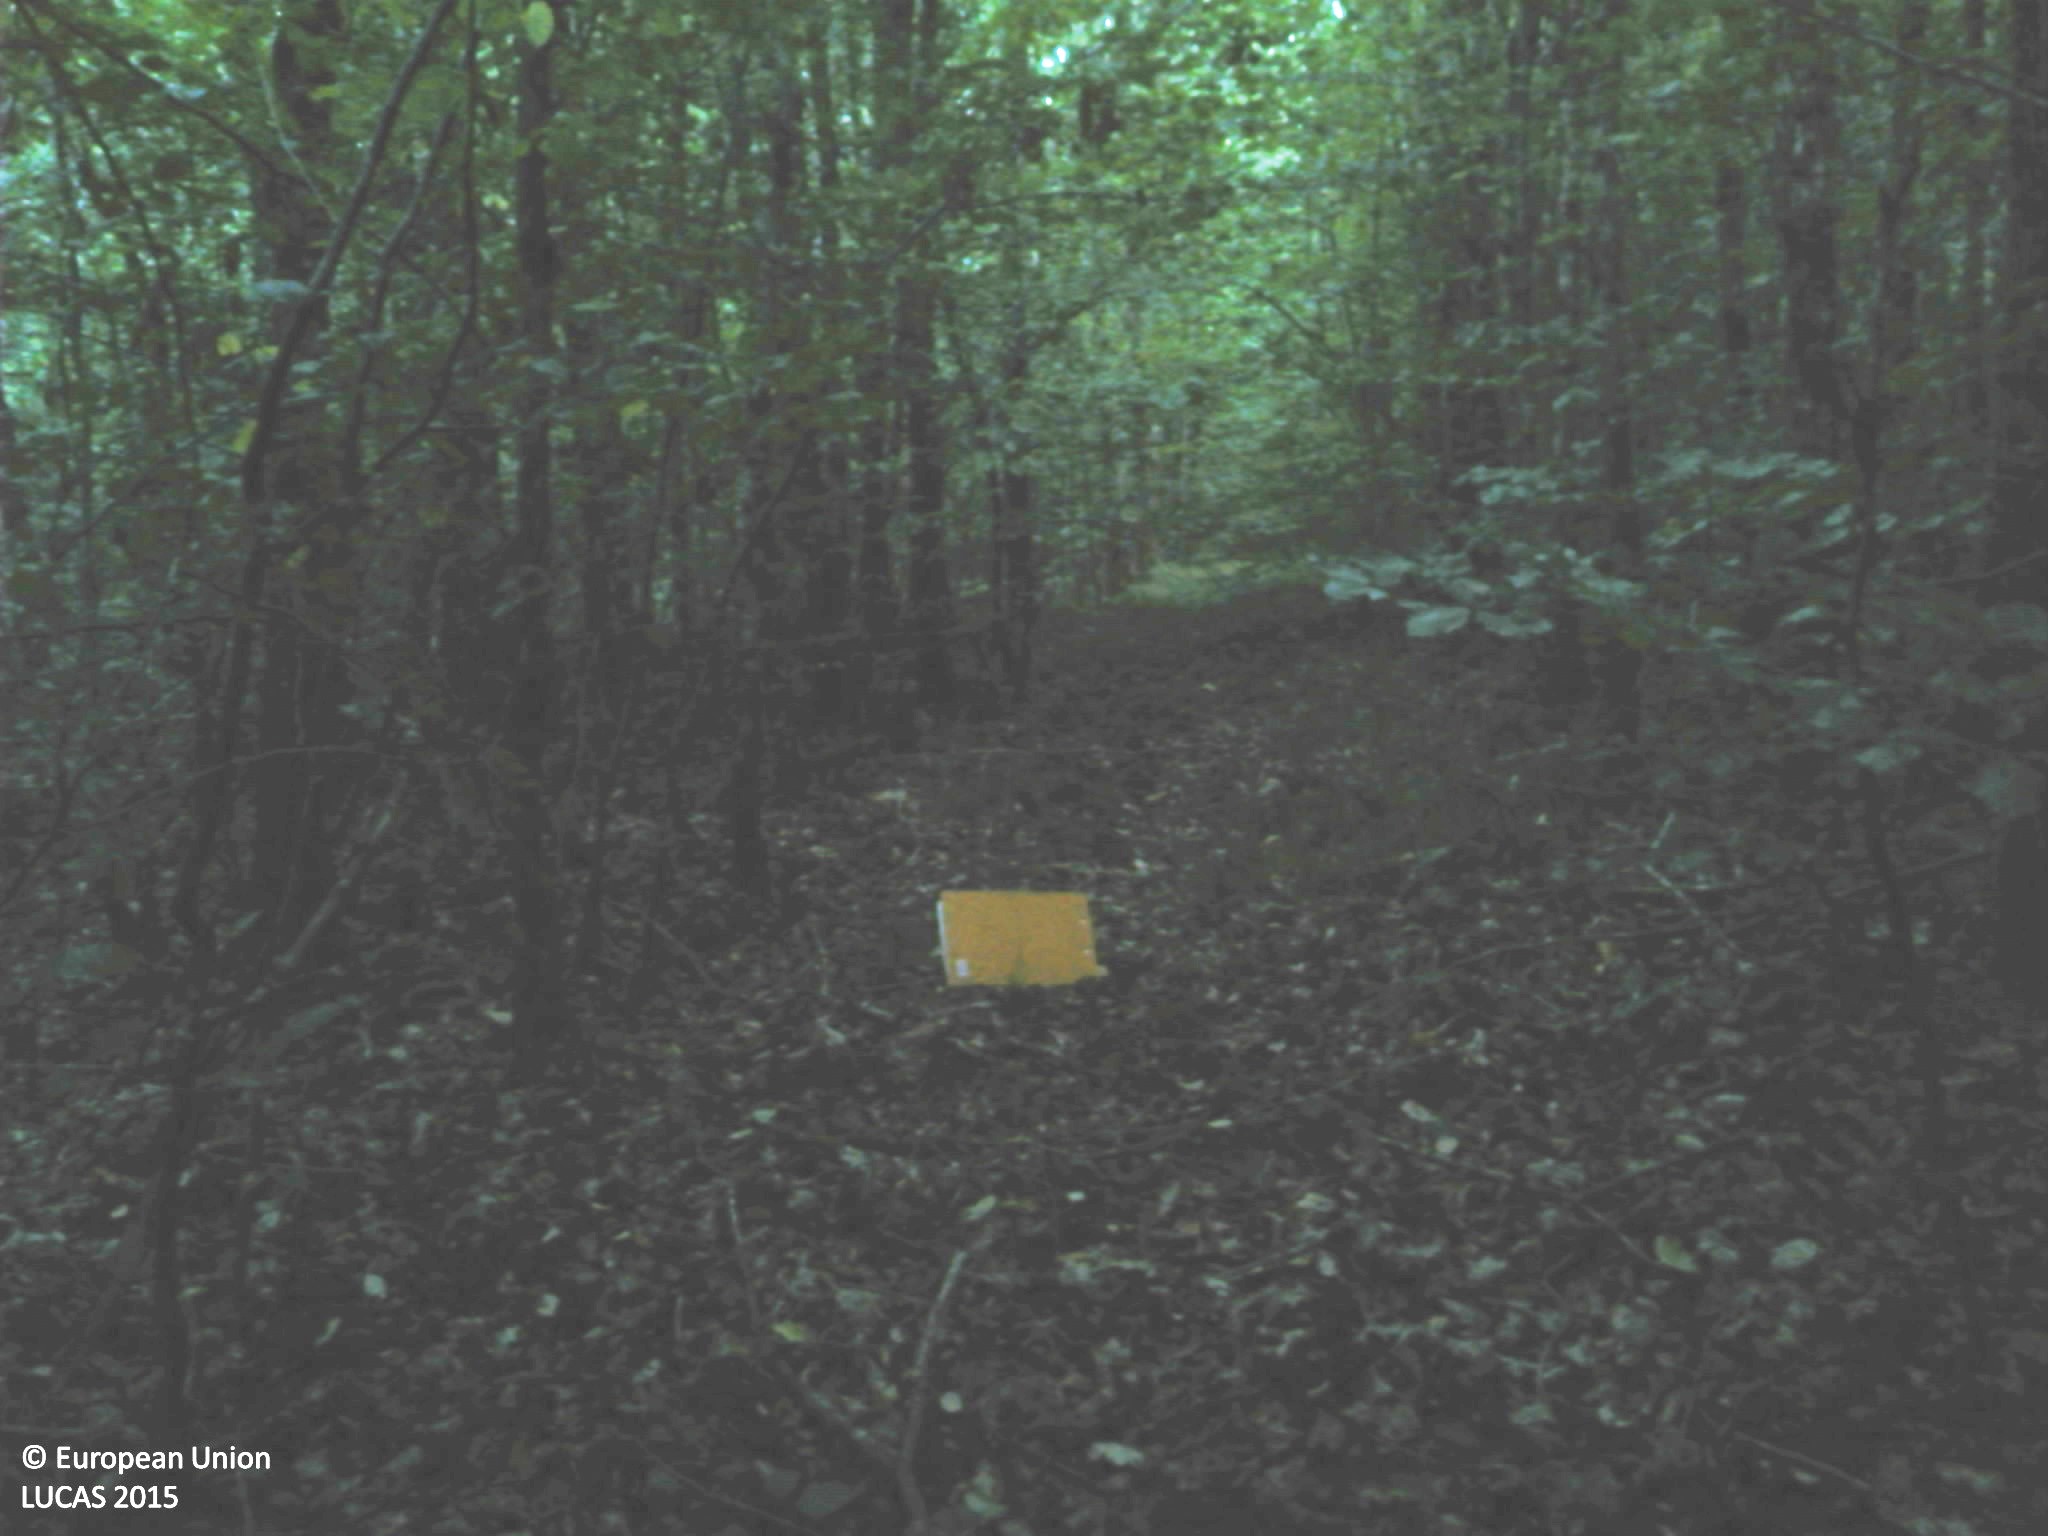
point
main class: Woodland
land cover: Broadleaved woodland
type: beech forest
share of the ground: > 75 %
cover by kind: broadleaved forest trees 90 %, unconsolidated bare surface 10 %
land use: Forestry
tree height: > 5 m
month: July
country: FR
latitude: 48.0643
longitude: 6.0956
